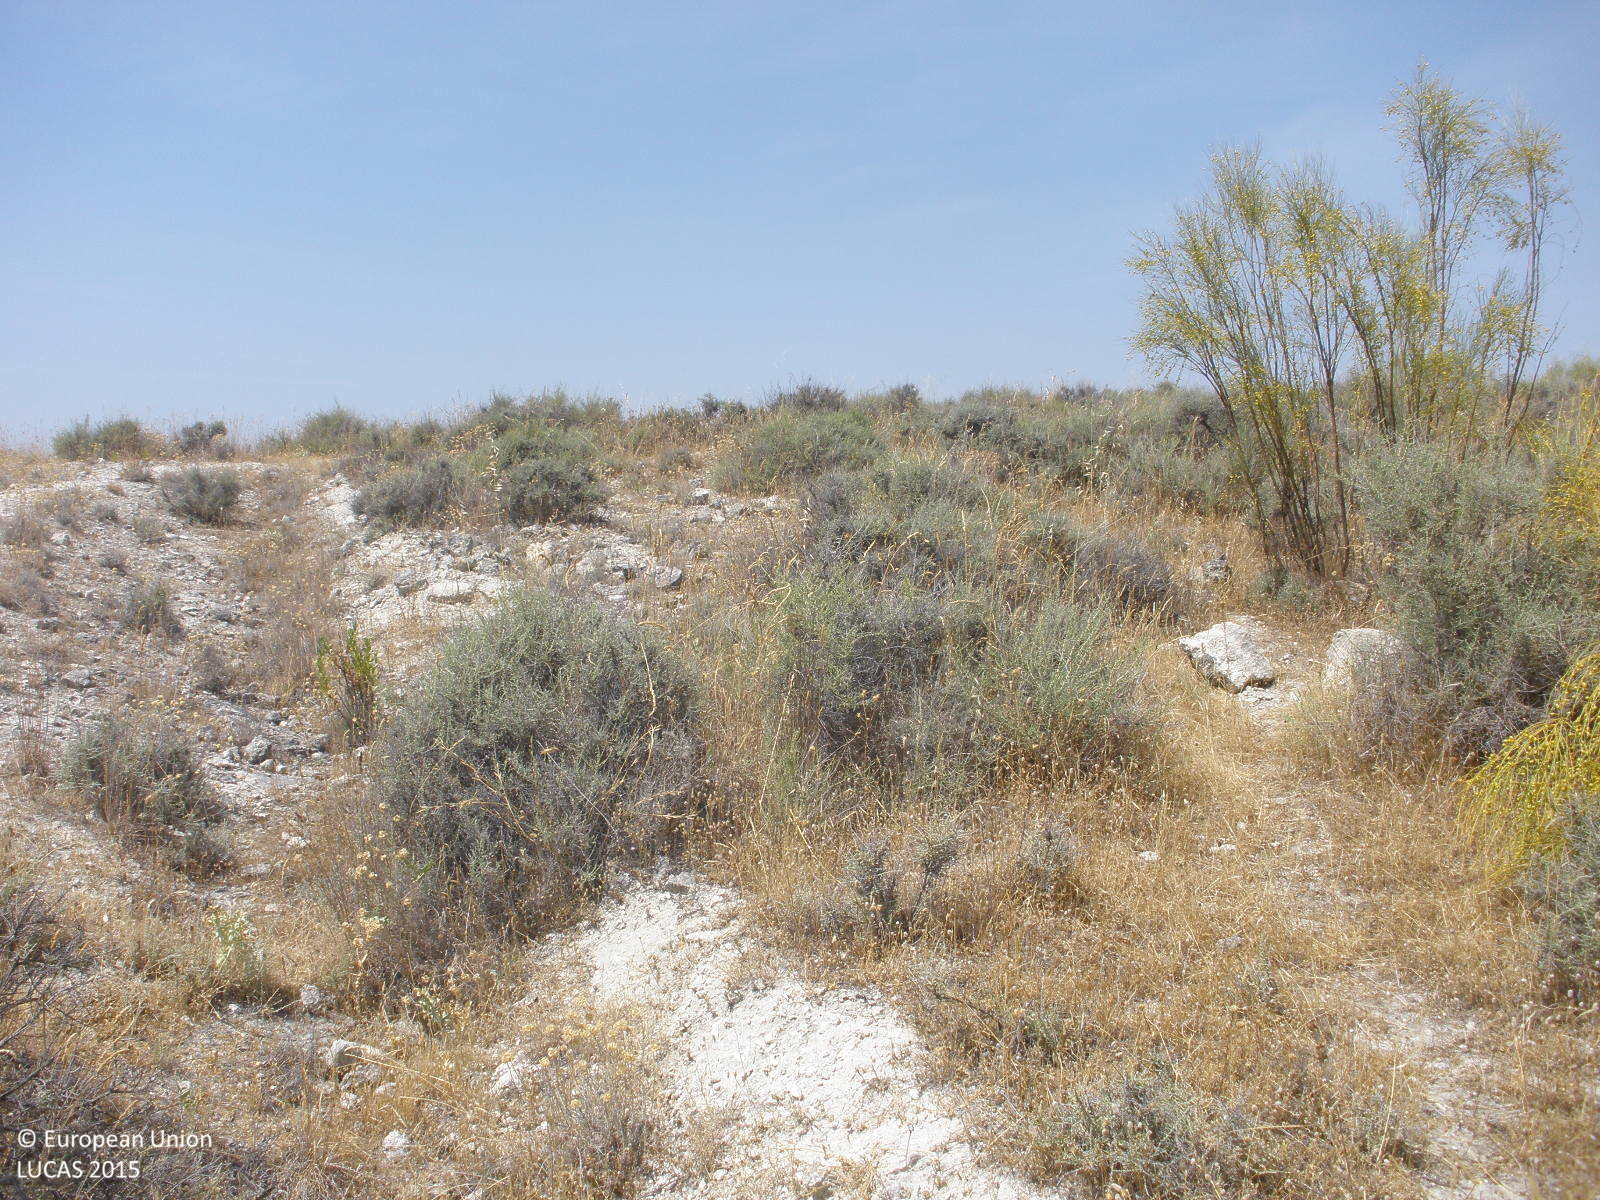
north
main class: Shrubland
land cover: Shrubland without tree cover
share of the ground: 50 - 75 %
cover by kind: shrubs 50 %, herbaceous plants 30 %, consolidated bare surface 20 %
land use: Semi-natural and natural areas not in use
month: July
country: ES
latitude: 40.3351
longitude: -3.5118
